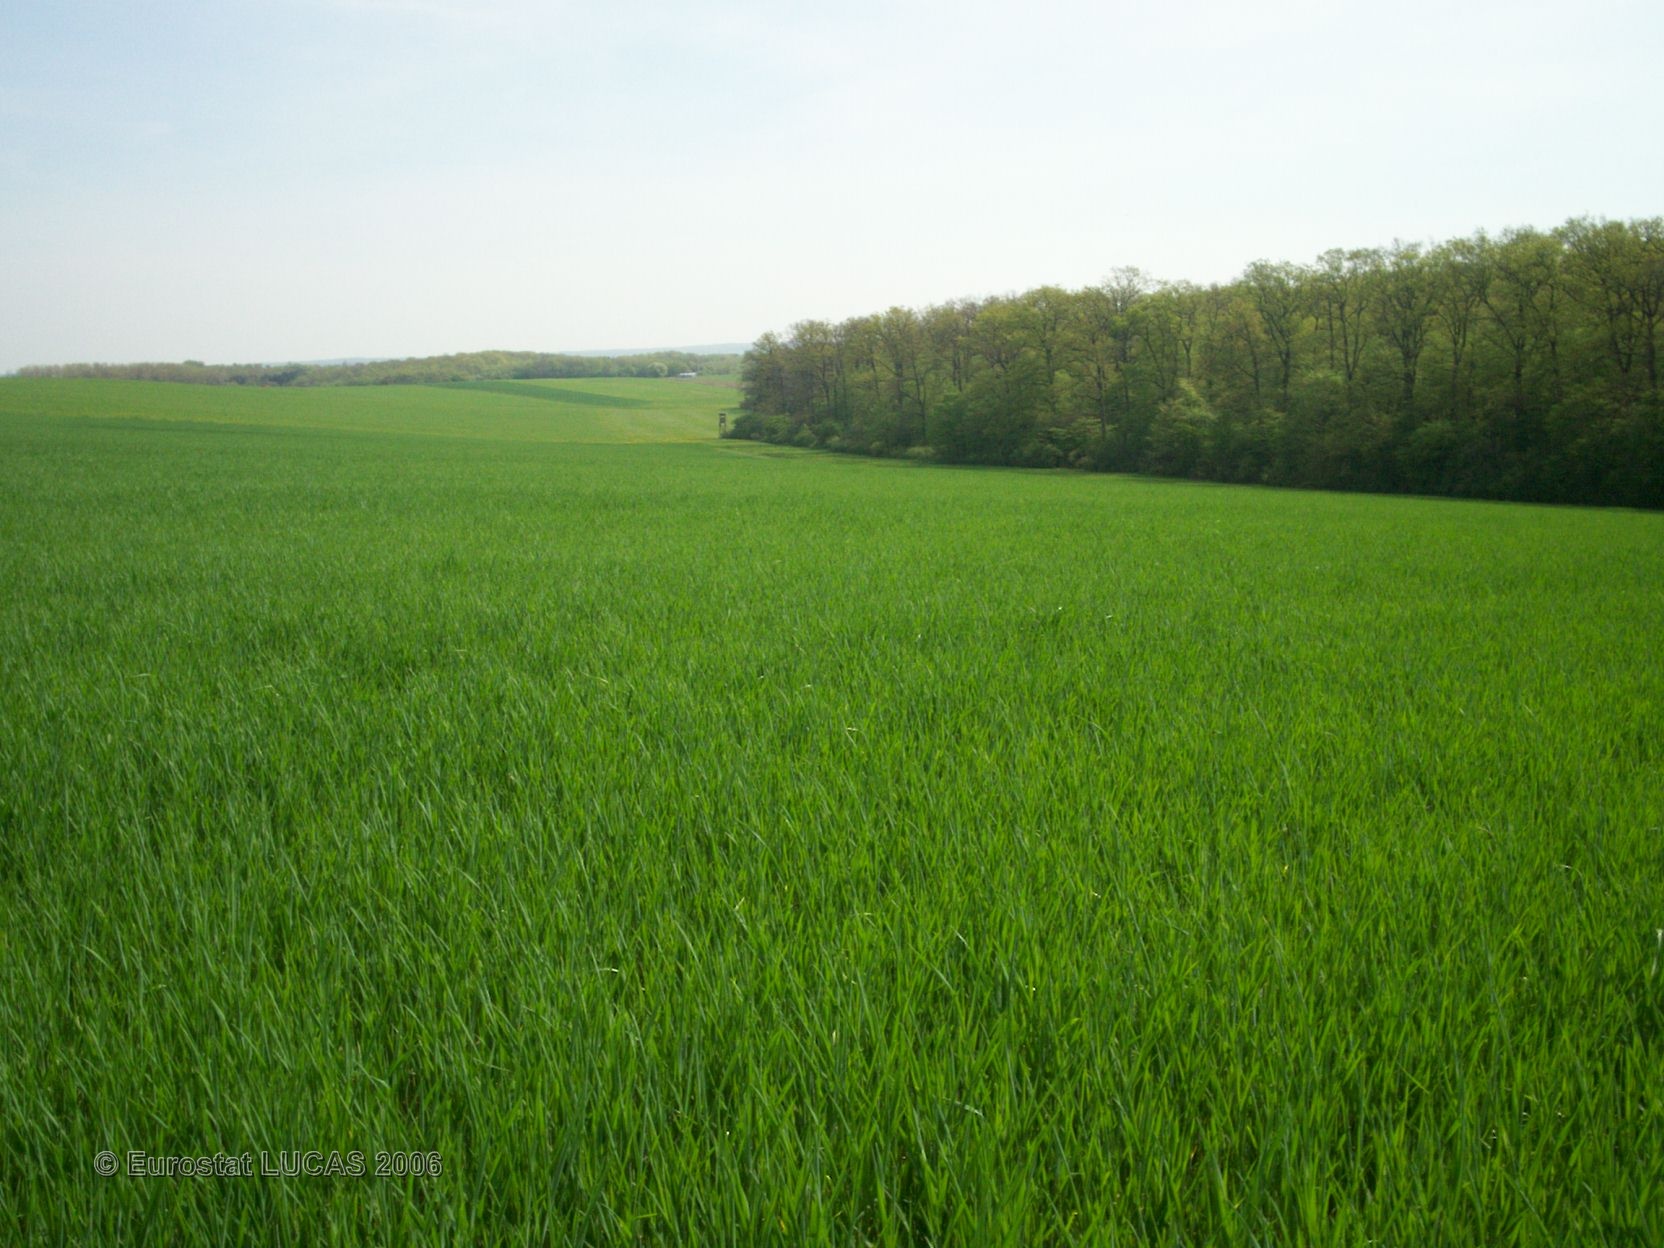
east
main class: Cropland
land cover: Barley
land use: Agriculture (excluding fallow land and kitchen gardens)
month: May
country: FR
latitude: 48.9205
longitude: 6.9845
